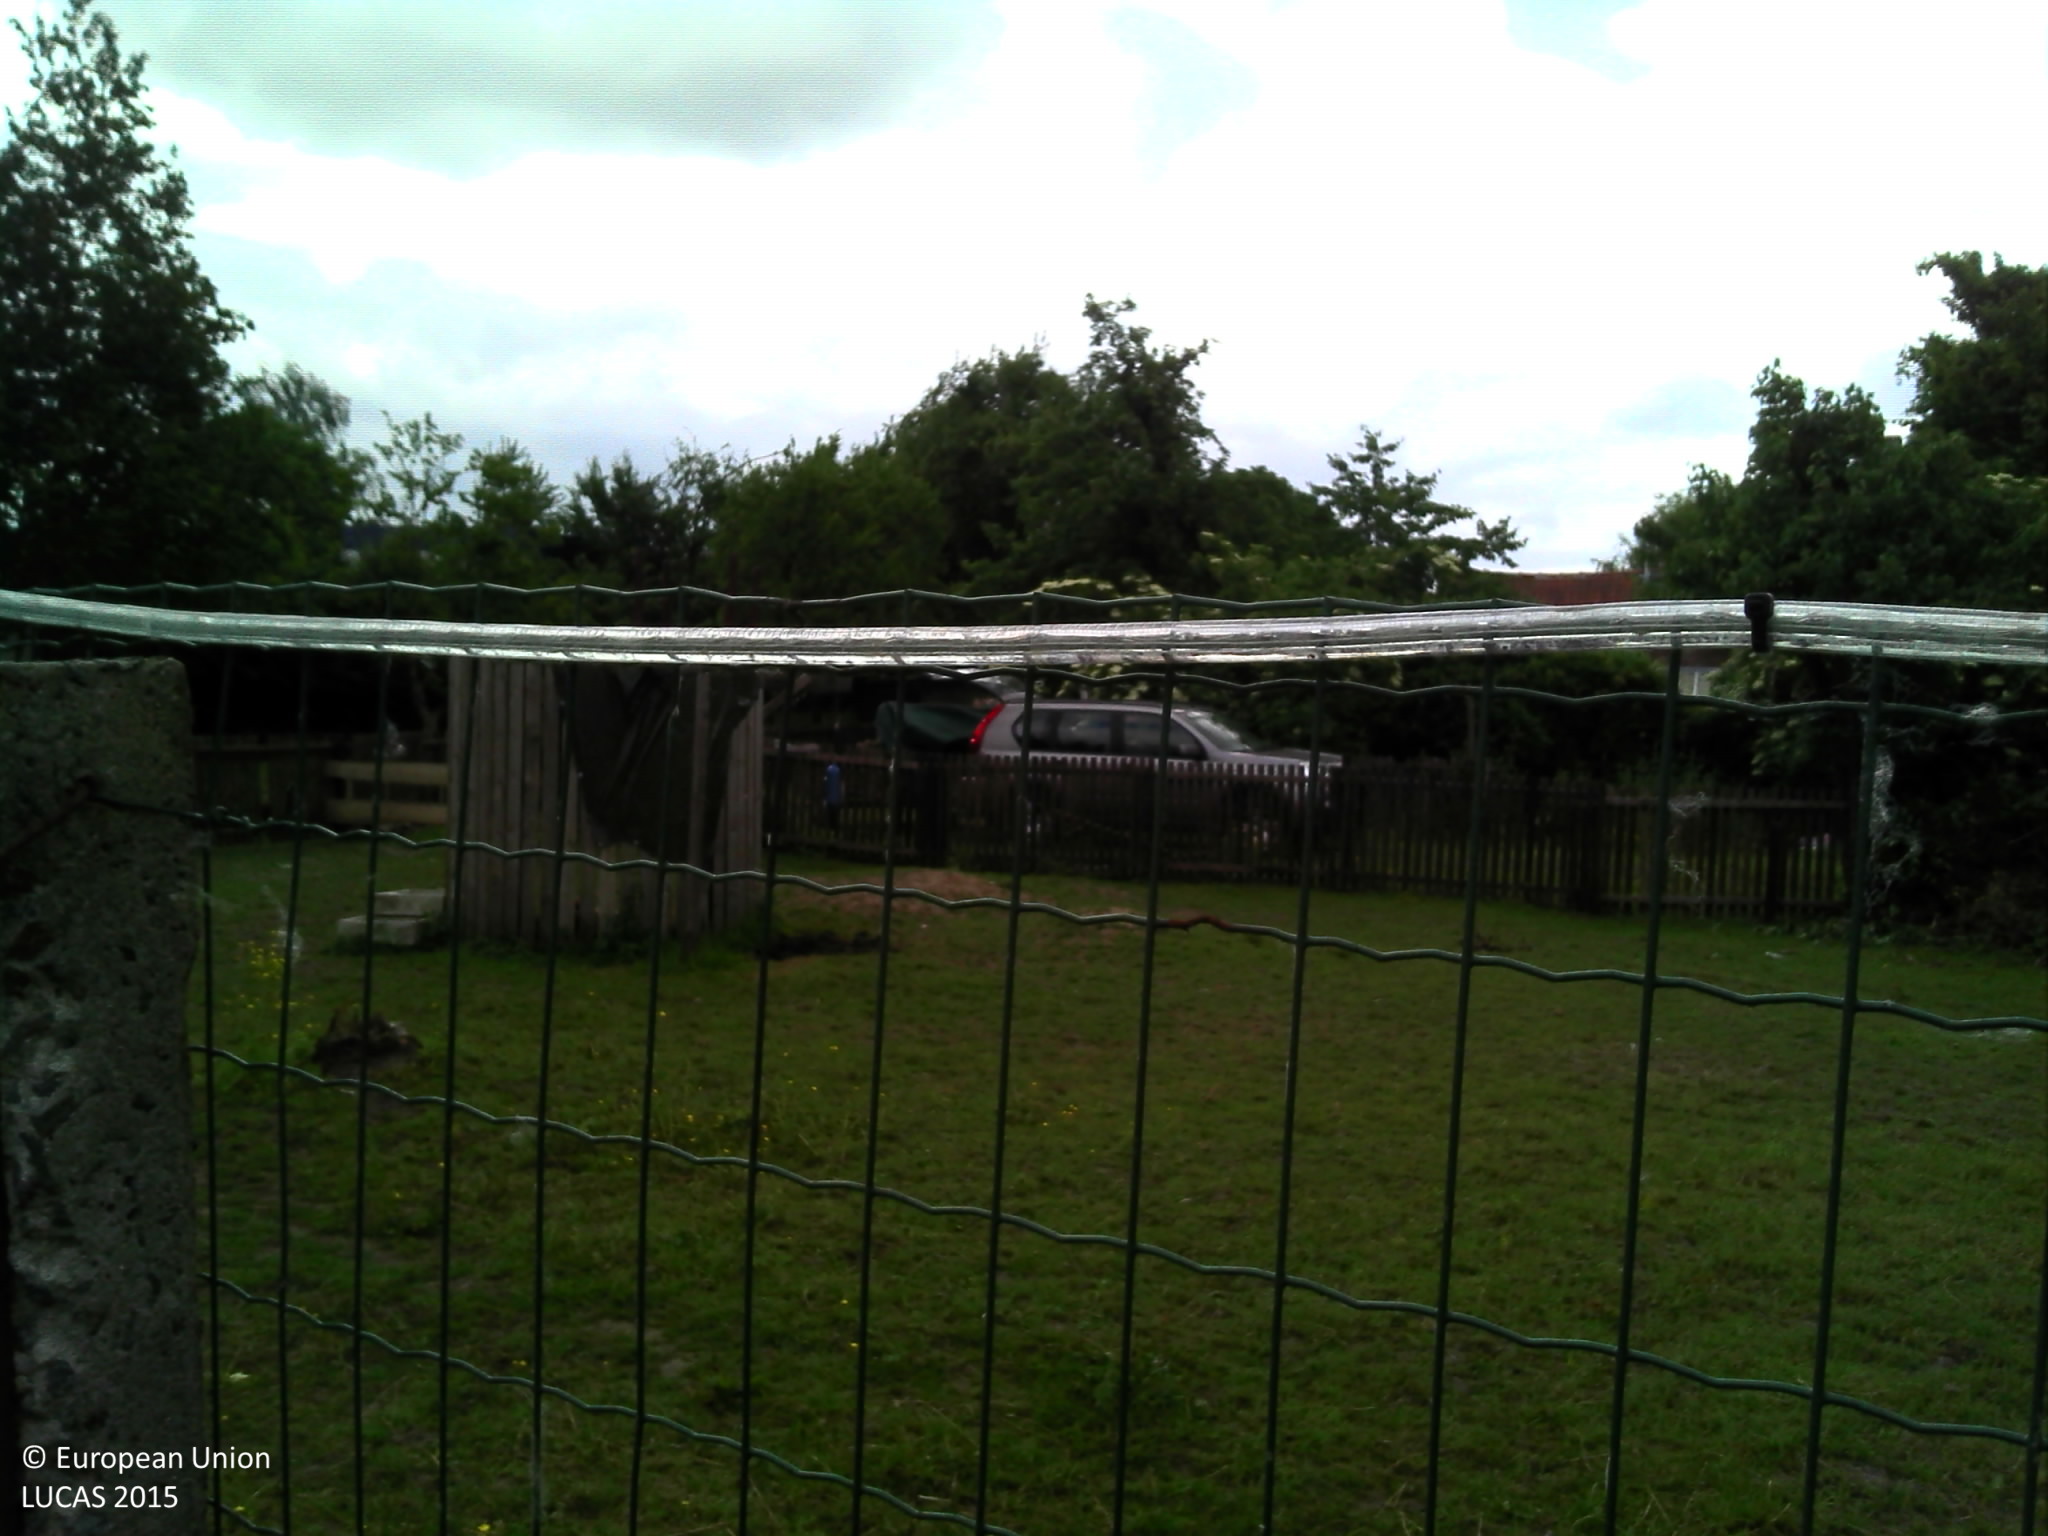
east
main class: Grassland
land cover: Grassland with sparse tree/shrub cover
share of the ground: > 75 %
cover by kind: herbaceous plants 95 %, broadleaved forest trees 5 %
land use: Residential
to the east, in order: Grassland with sparse tree/shrub cover; Artificial constructions in urban areas; Potatoes
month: June
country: BE
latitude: 50.9653
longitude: 4.0281
